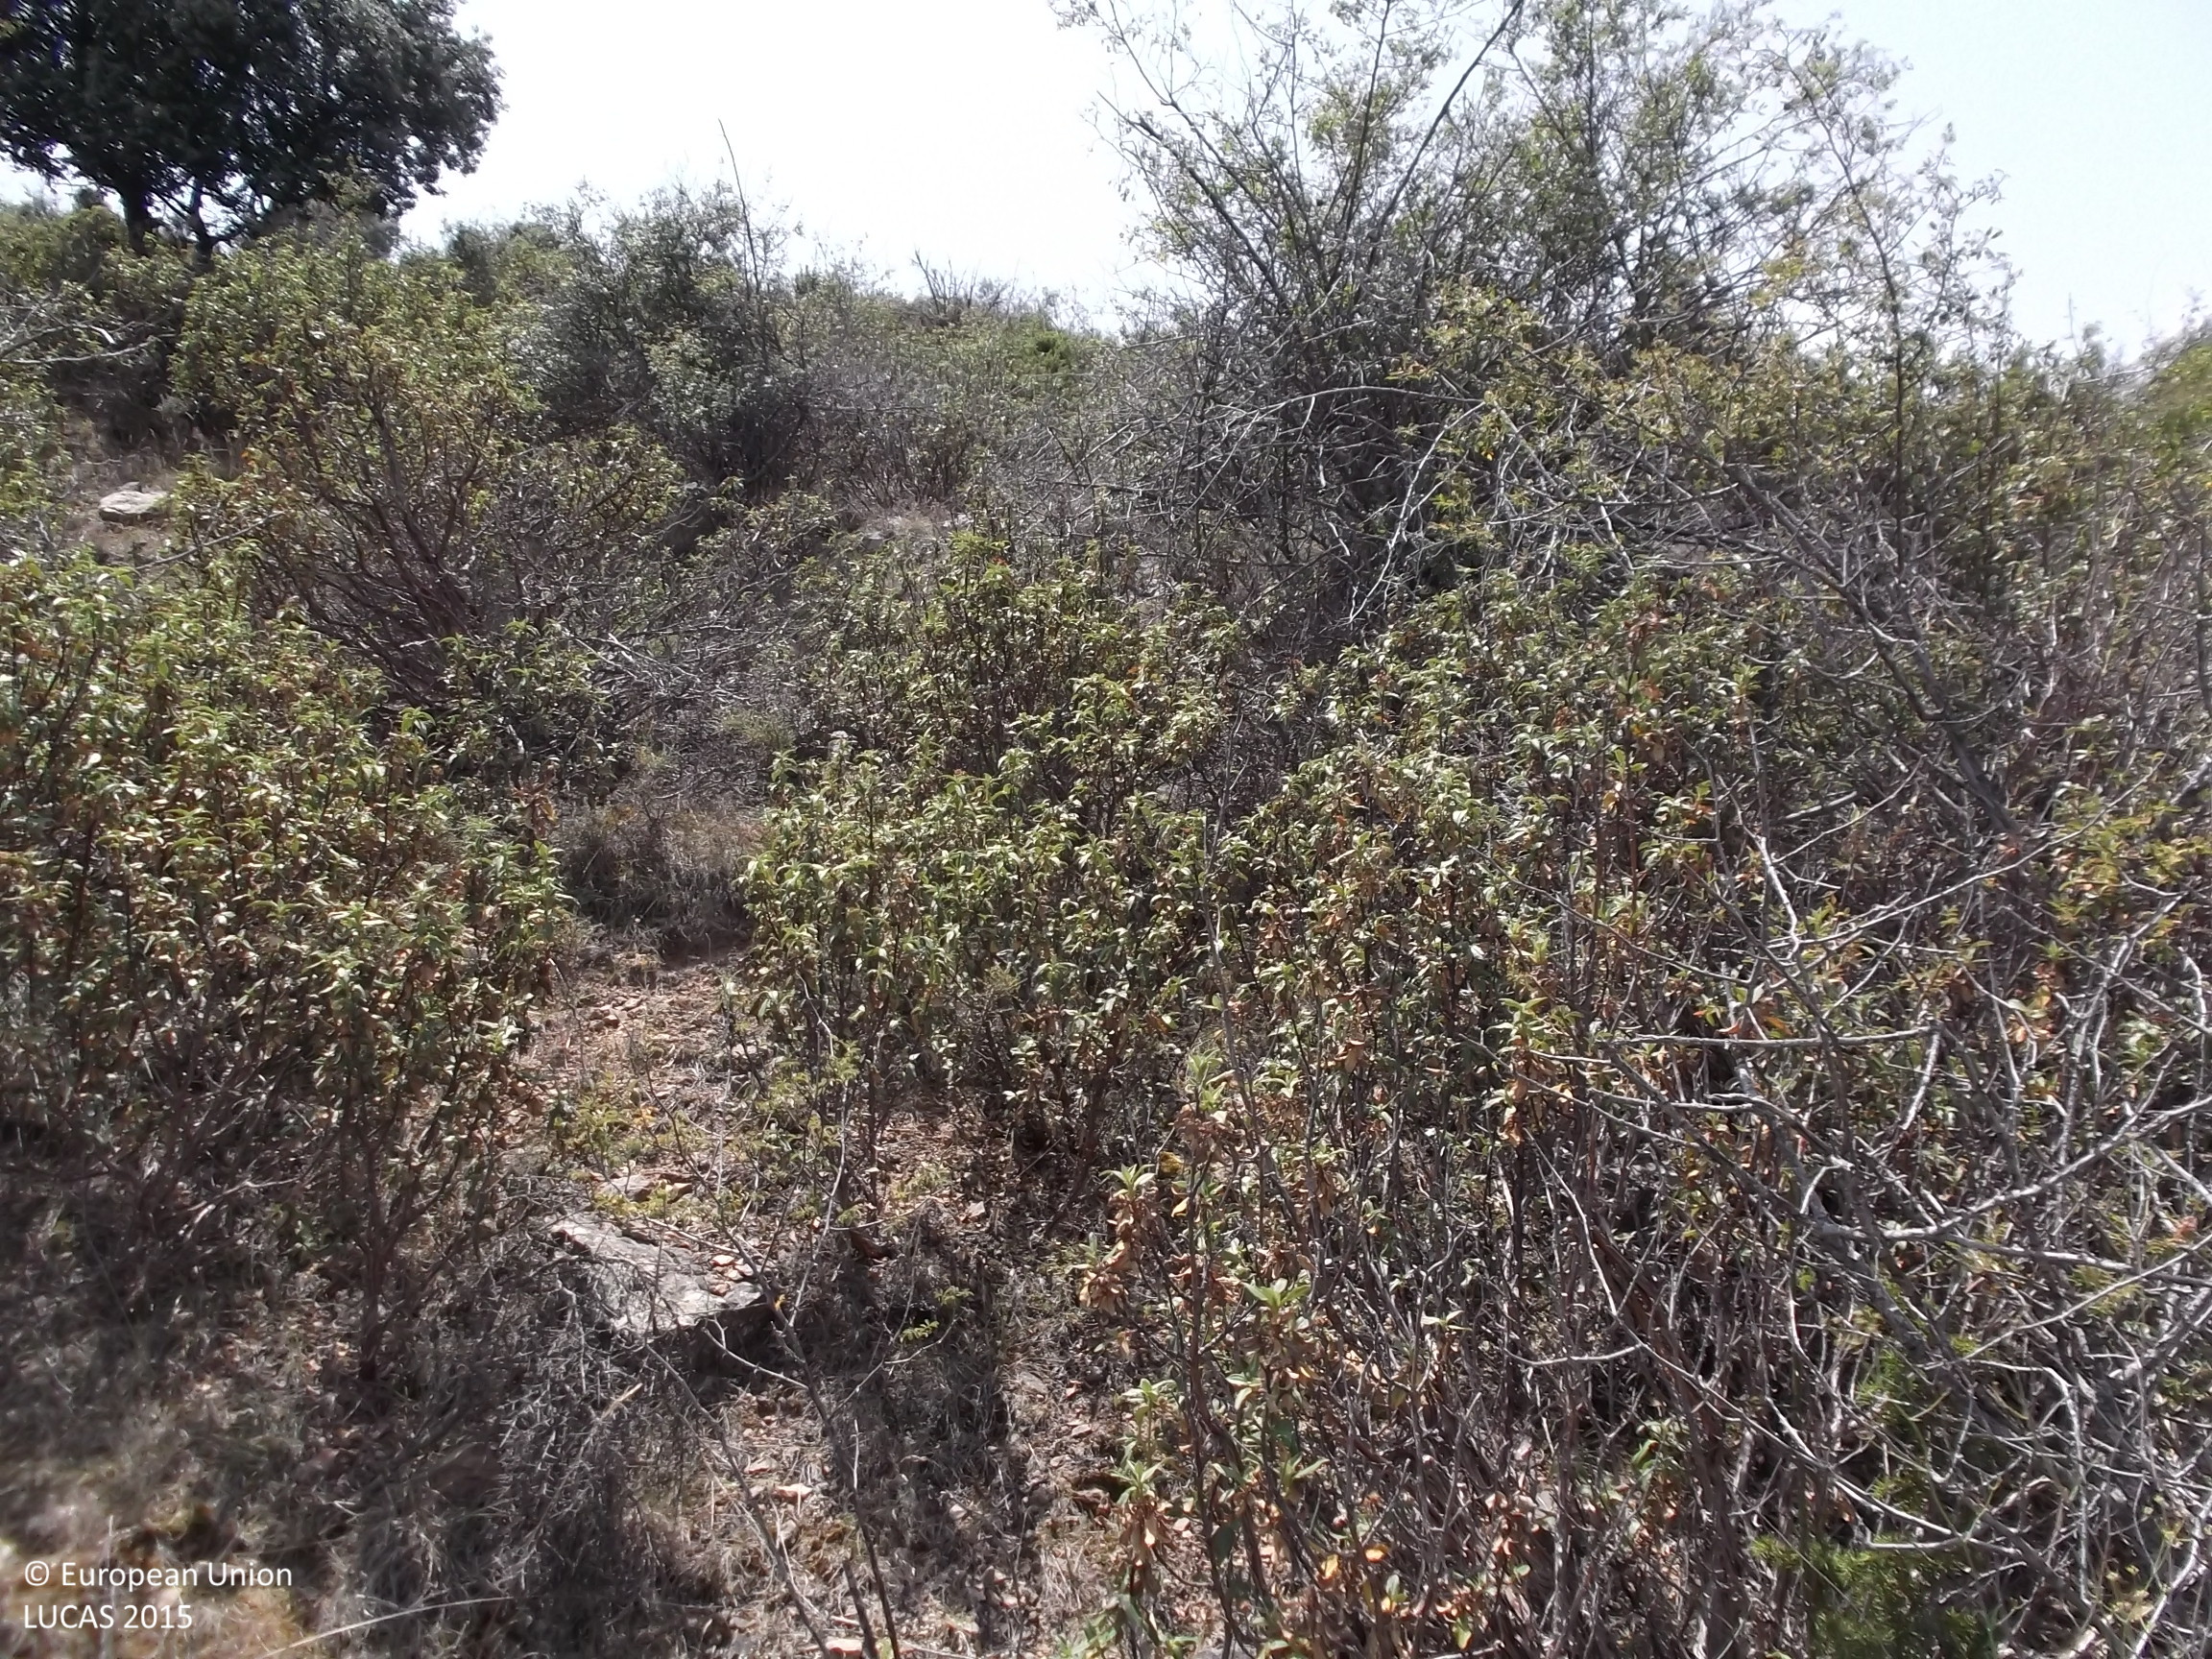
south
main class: Shrubland
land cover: Shrubland with sparse tree cover
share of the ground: > 75 %
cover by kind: shrubs 80 %, unconsolidated bare surface 15 %, broadleaved forest trees 5 %
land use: Agriculture (excluding fallow land and kitchen gardens)
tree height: < 5 m
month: July
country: ES
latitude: 42.0227
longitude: -2.0527
